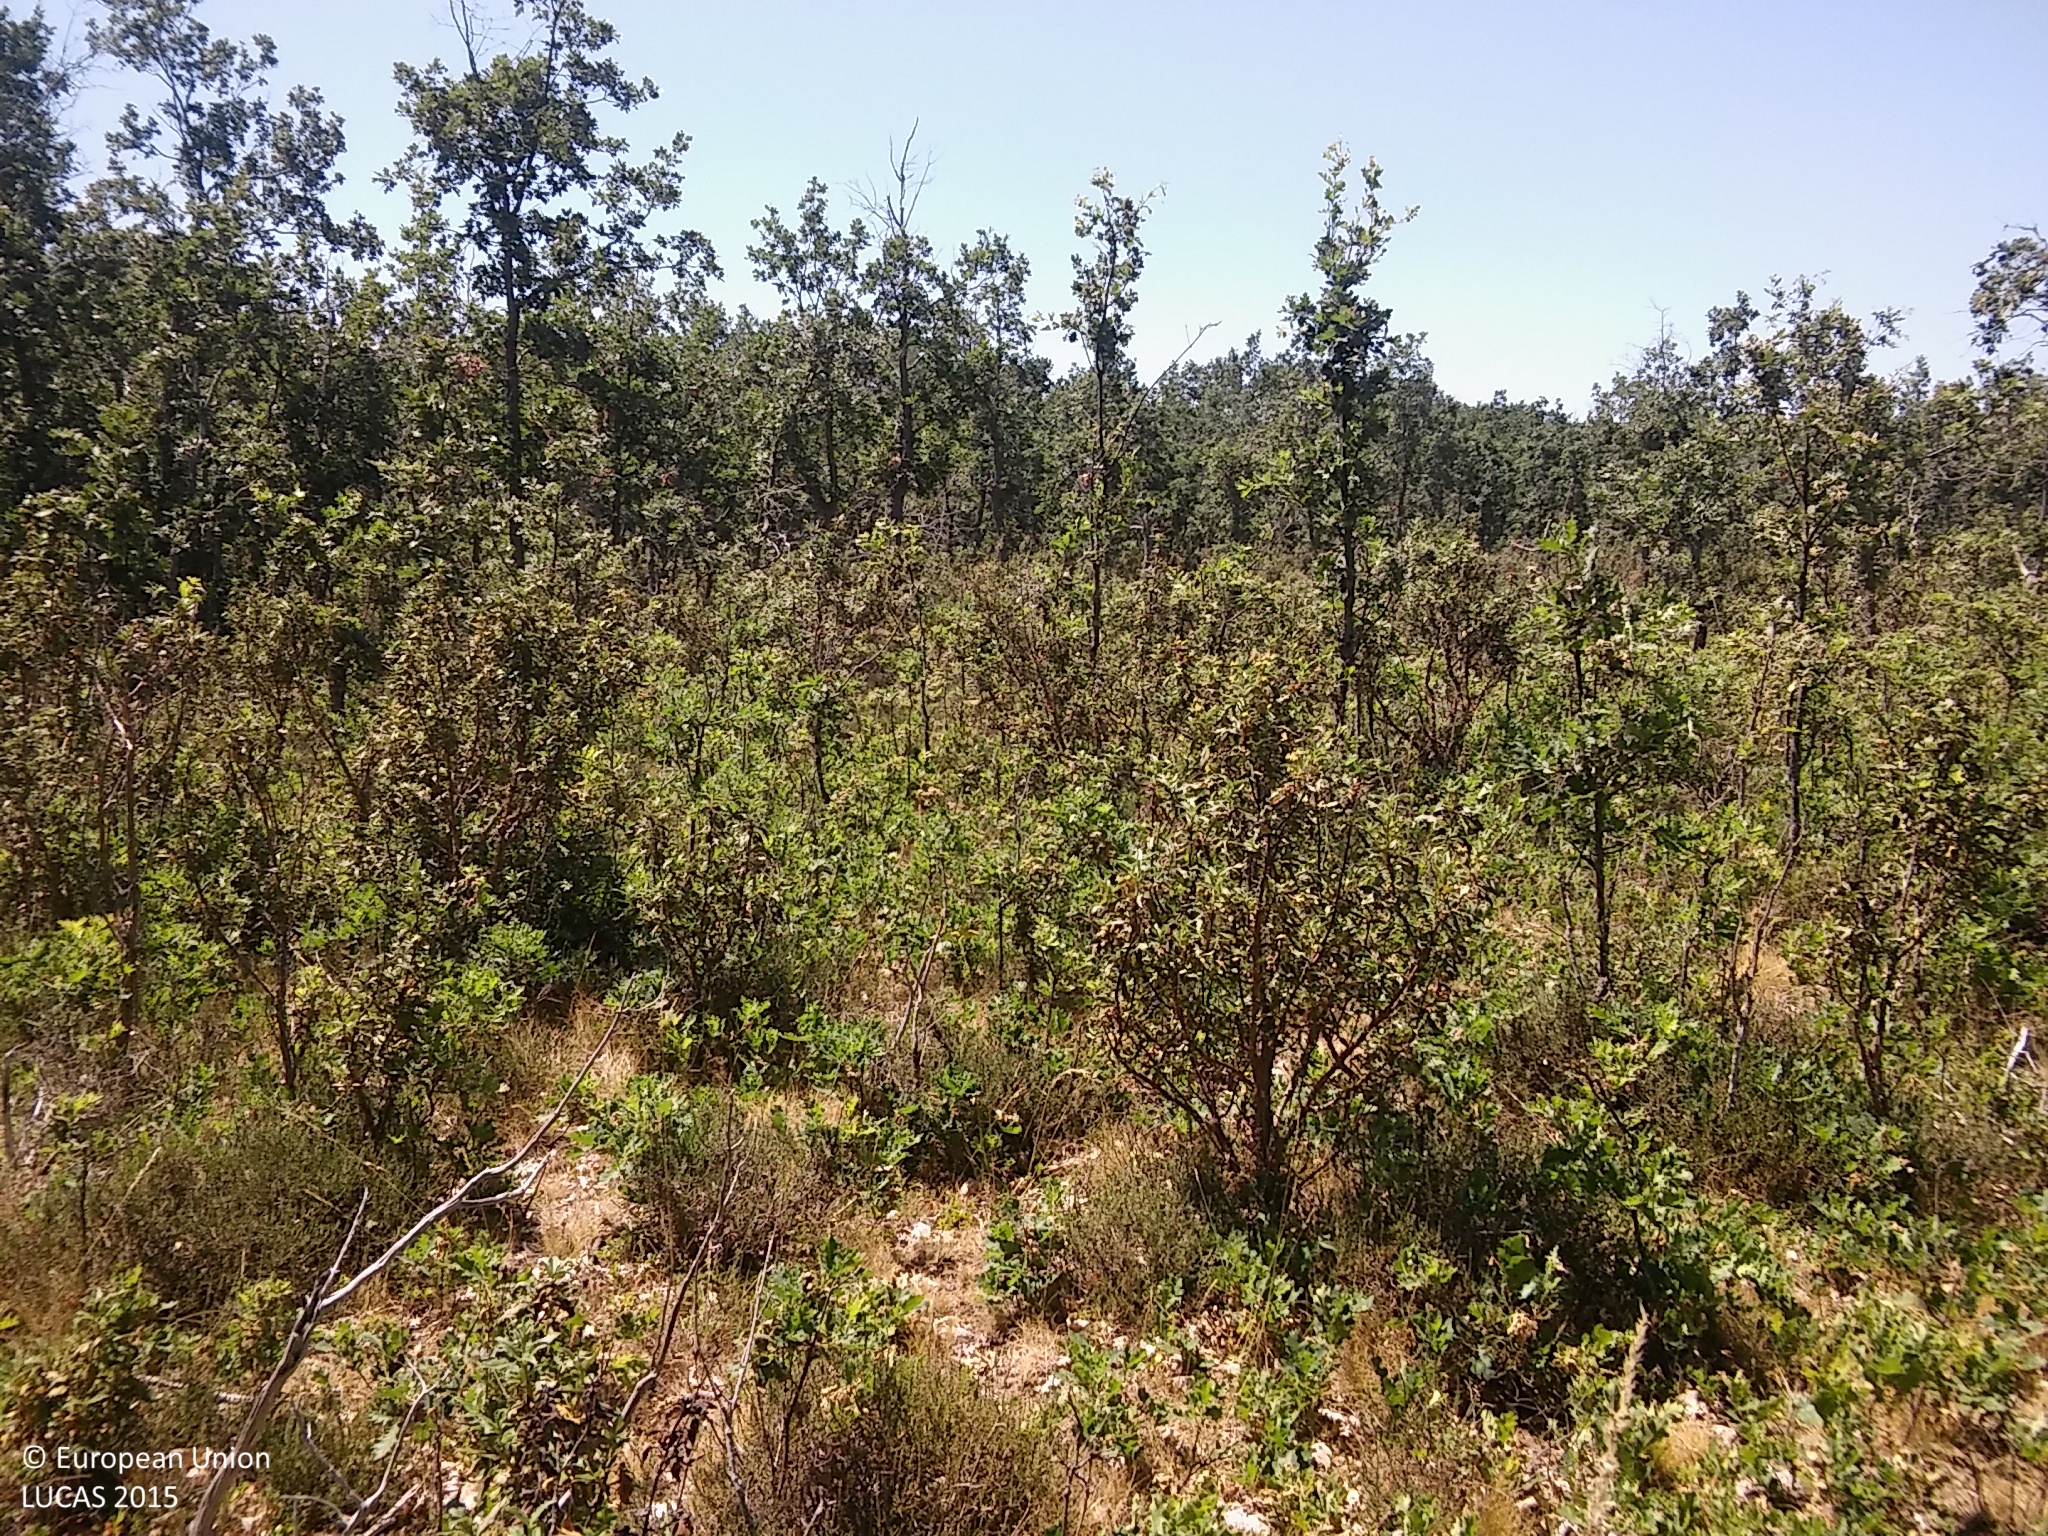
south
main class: Woodland
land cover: Broadleaved woodland
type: acidophilous oak and oak-birch forest
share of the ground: 25 - 50 %
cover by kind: shrubs 40 %, broadleaved forest trees 30 %, herbaceous plants 30 %
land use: Forestry
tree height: > 5 m
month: July
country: ES
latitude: 41.2880
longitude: -3.5027
